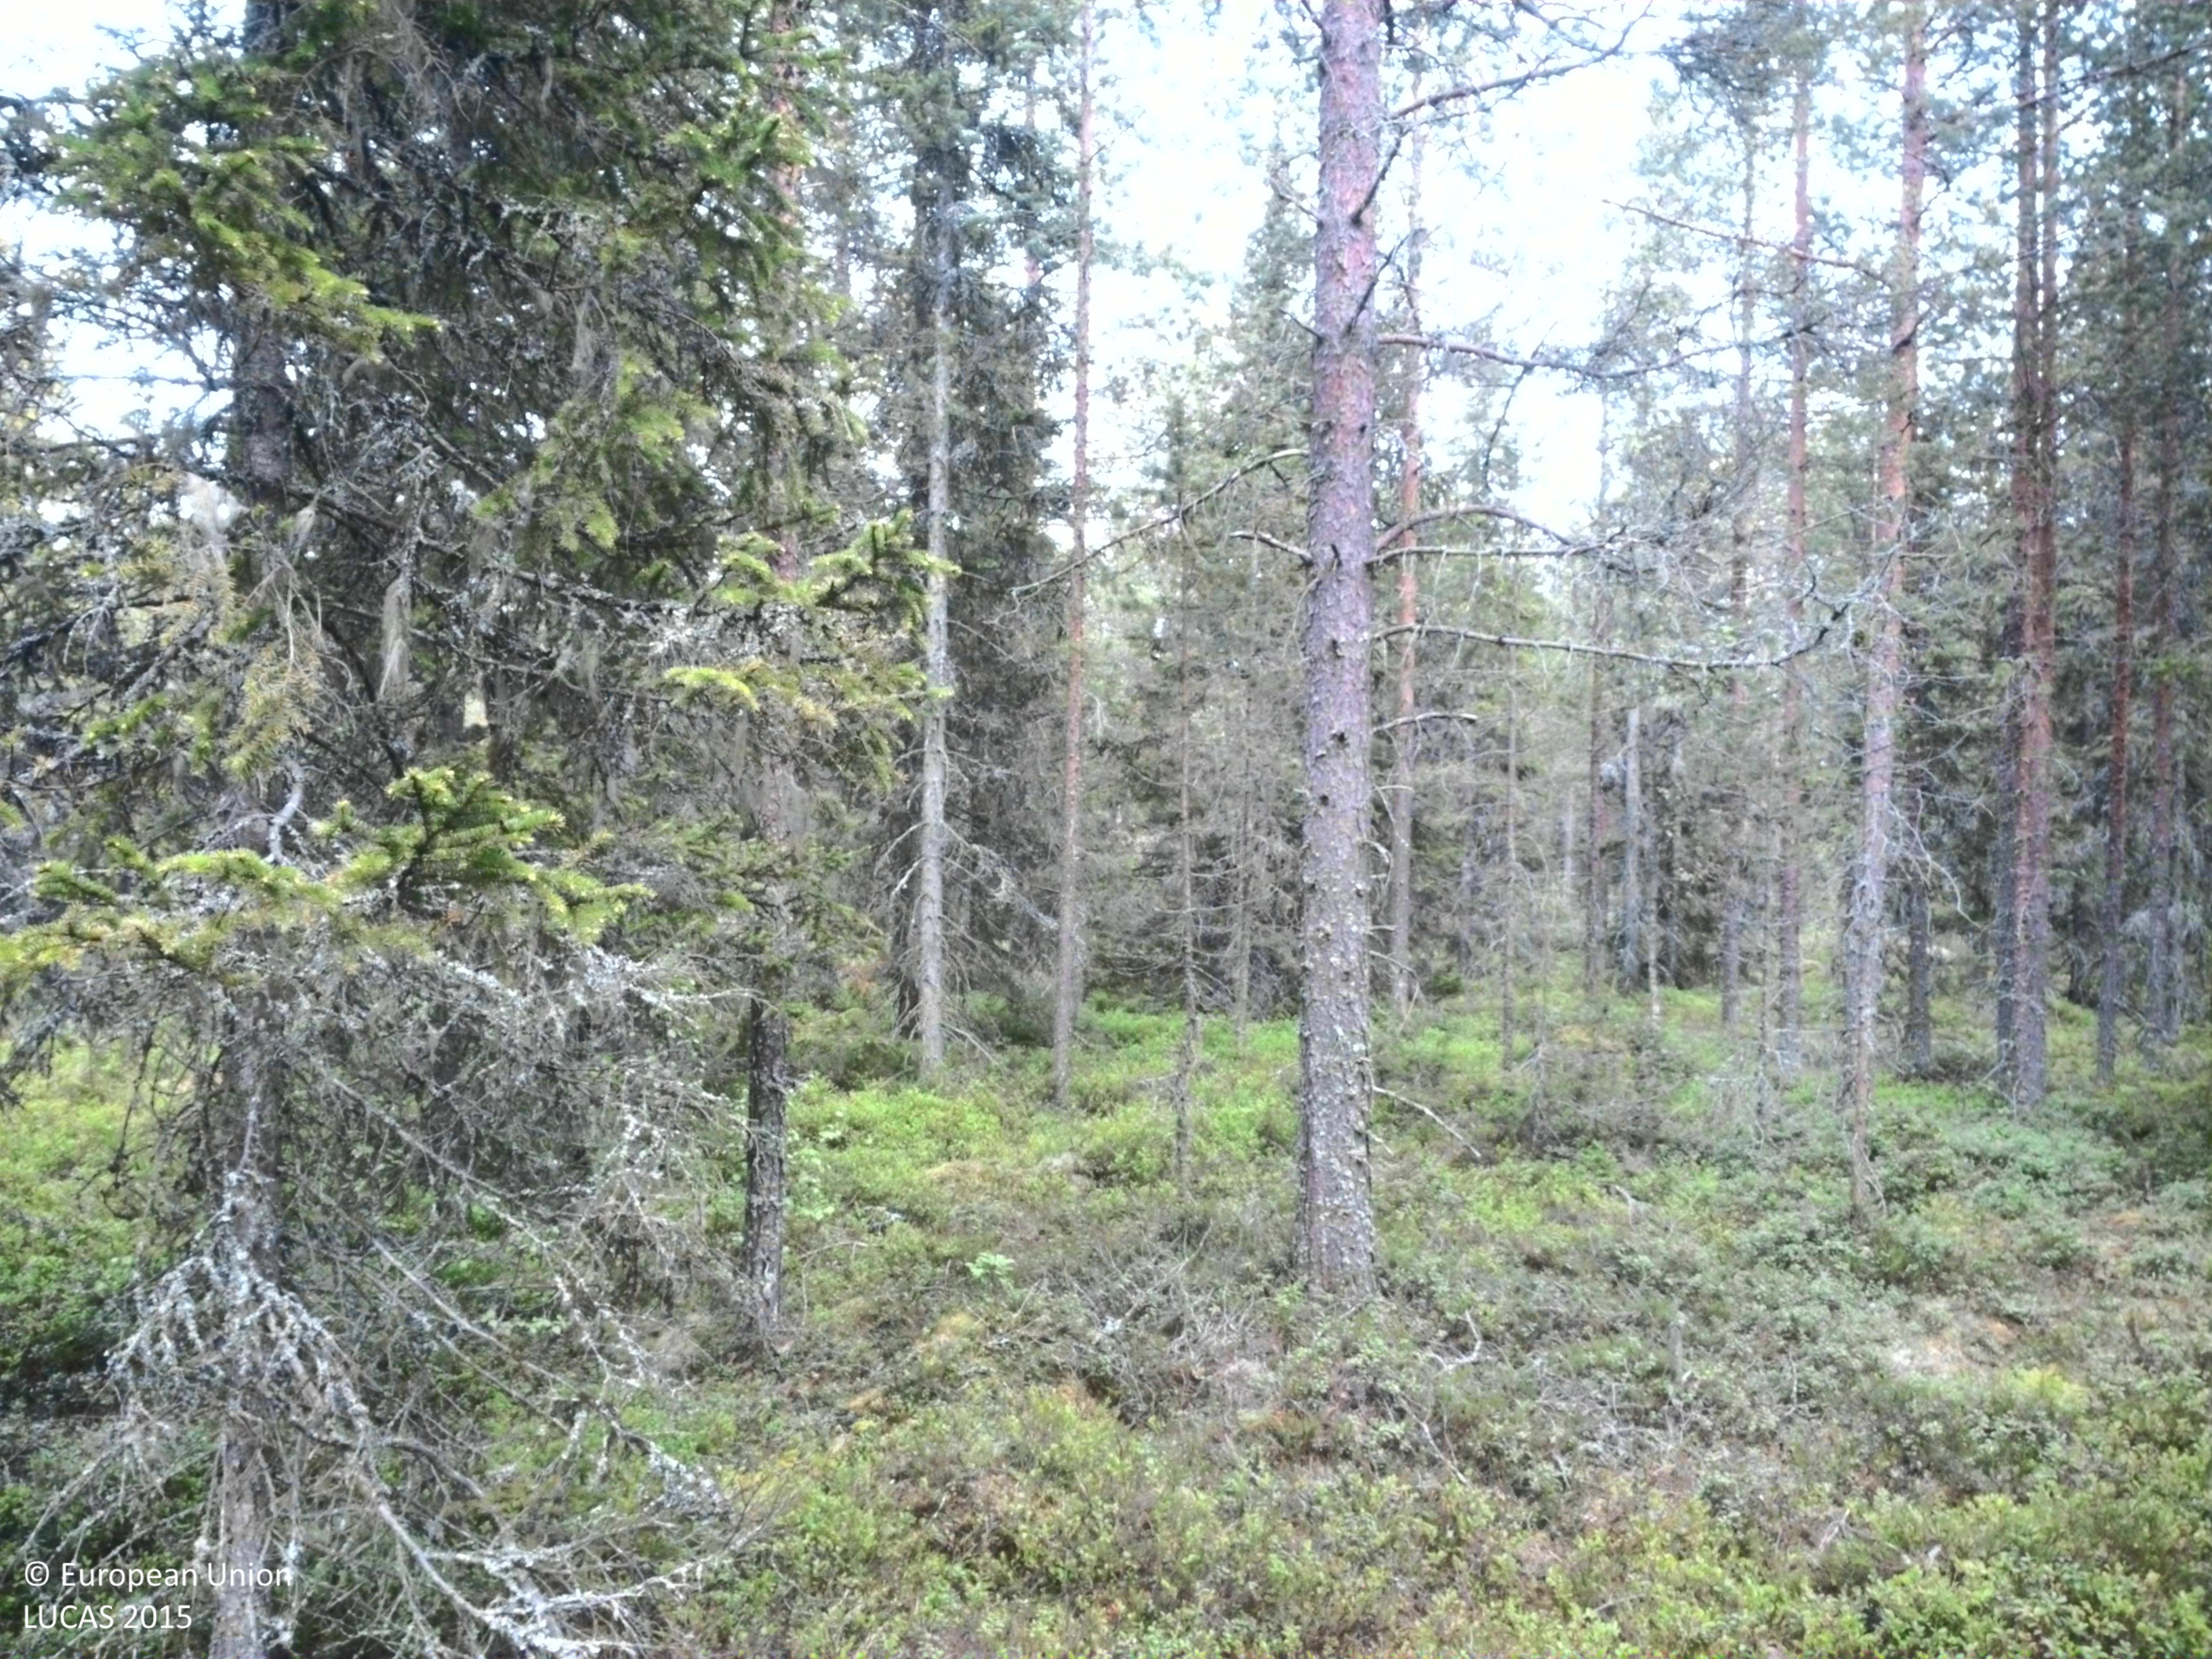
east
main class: Woodland
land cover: Other coniferous woodland
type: boreal forest
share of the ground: 25 - 50 %
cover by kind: coniferous forest trees 50 %, shrubs 40 %, herbaceous plants 5 %, lichens and mosses 5 %
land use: Amenities, museums, leisure
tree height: > 5 m
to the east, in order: Other coniferous woodland; Pine dominated coniferous woodland; Other mixed woodland; Rocks and stones; Spruce dominated coniferous woodland
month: June
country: SE
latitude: 63.8201
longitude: 20.6503
